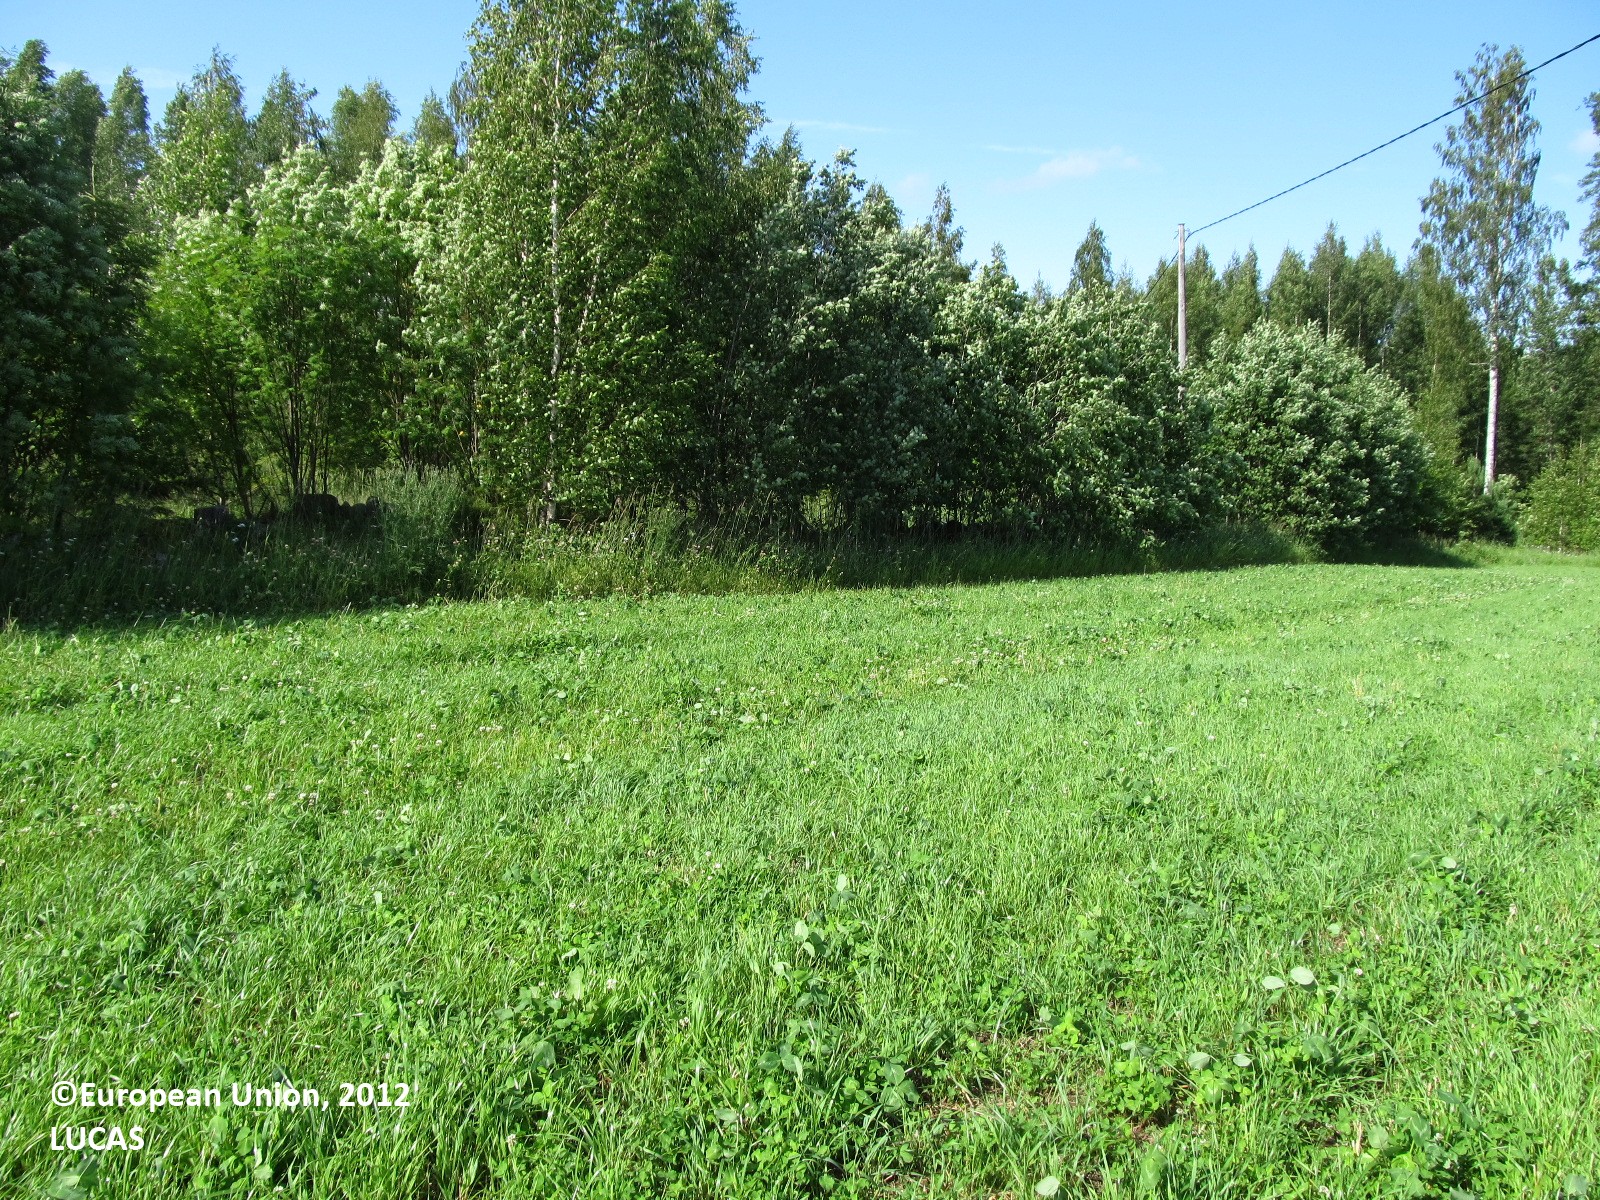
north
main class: Grassland
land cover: Spontaneously vegetated surfaces
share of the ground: > 75 %
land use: Agriculture (excluding fallow land and kitchen gardens)
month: July
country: FI
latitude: 61.9230
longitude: 28.4318
